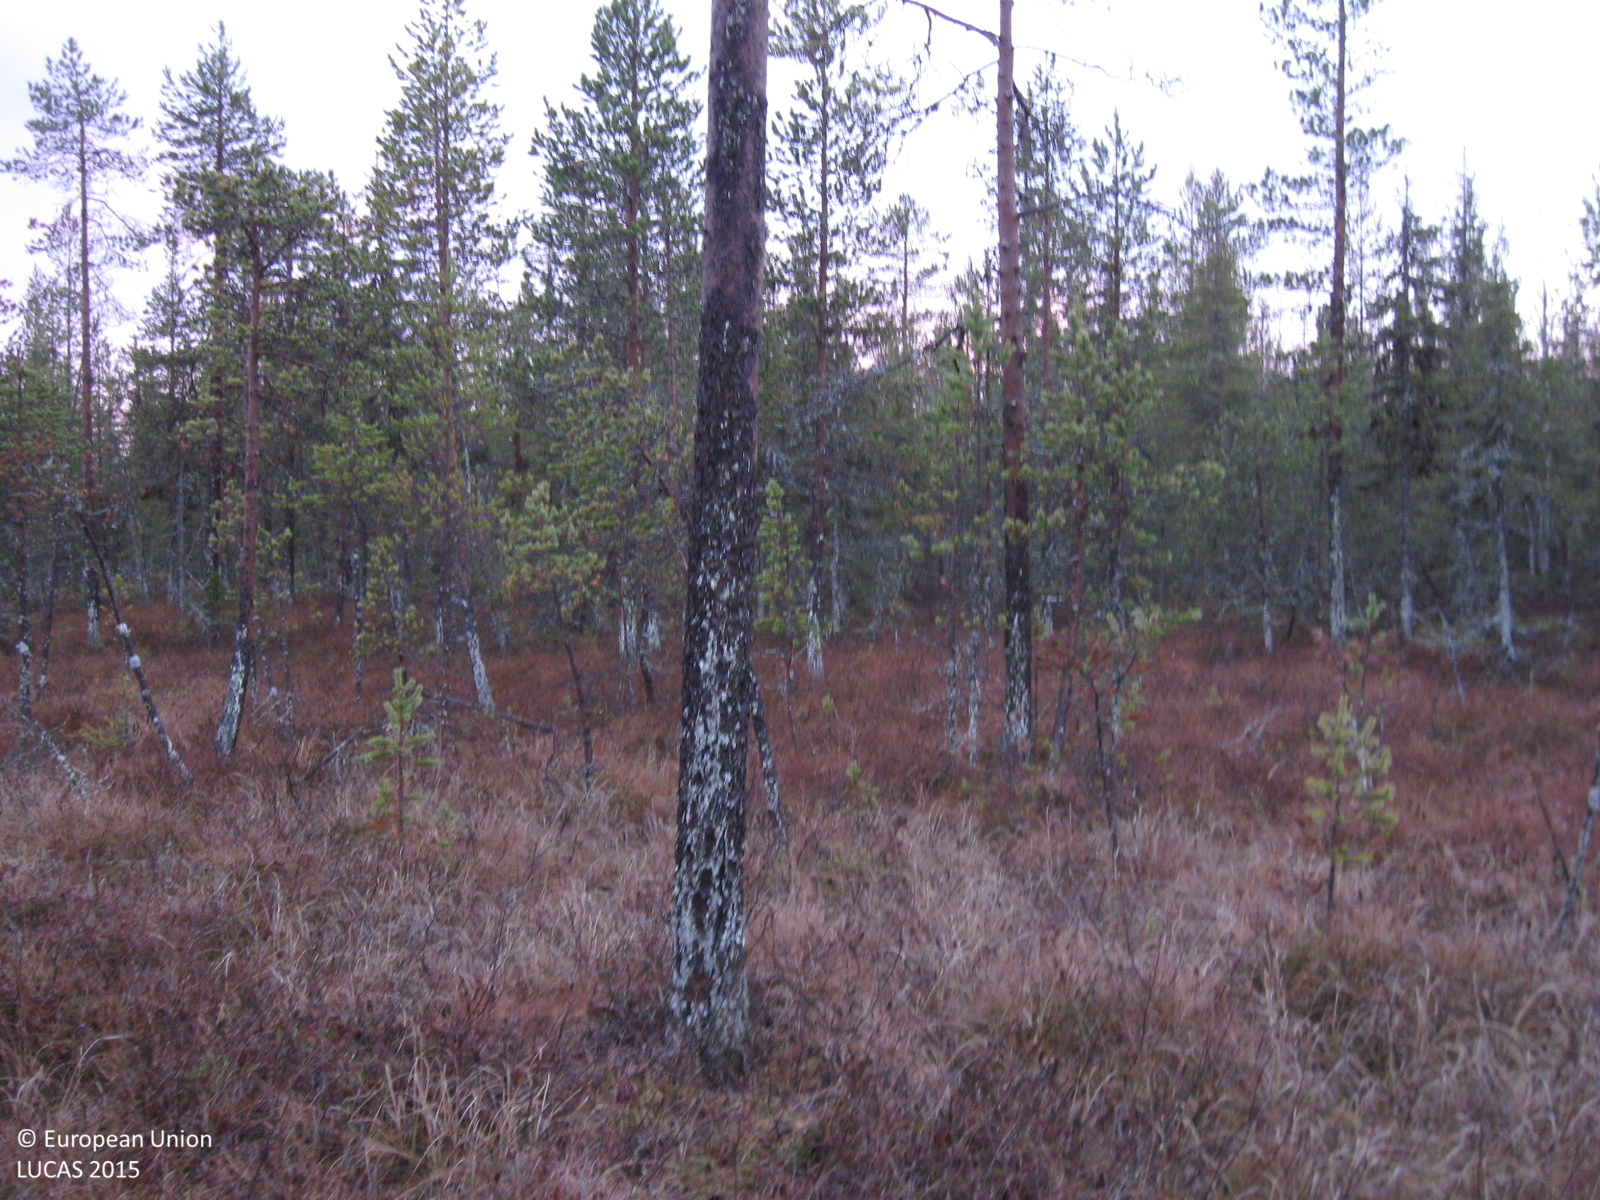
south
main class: Woodland
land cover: Pine dominated coniferous woodland
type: mire and swamp forests
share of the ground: 25 - 50 %
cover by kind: shrubs 40 %, coniferous forest trees 35 %, herbaceous plants 15 %, lichens and mosses 10 %
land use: Semi-natural and natural areas not in use
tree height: < 5 m
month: October
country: SE
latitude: 66.4341
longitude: 20.9201
